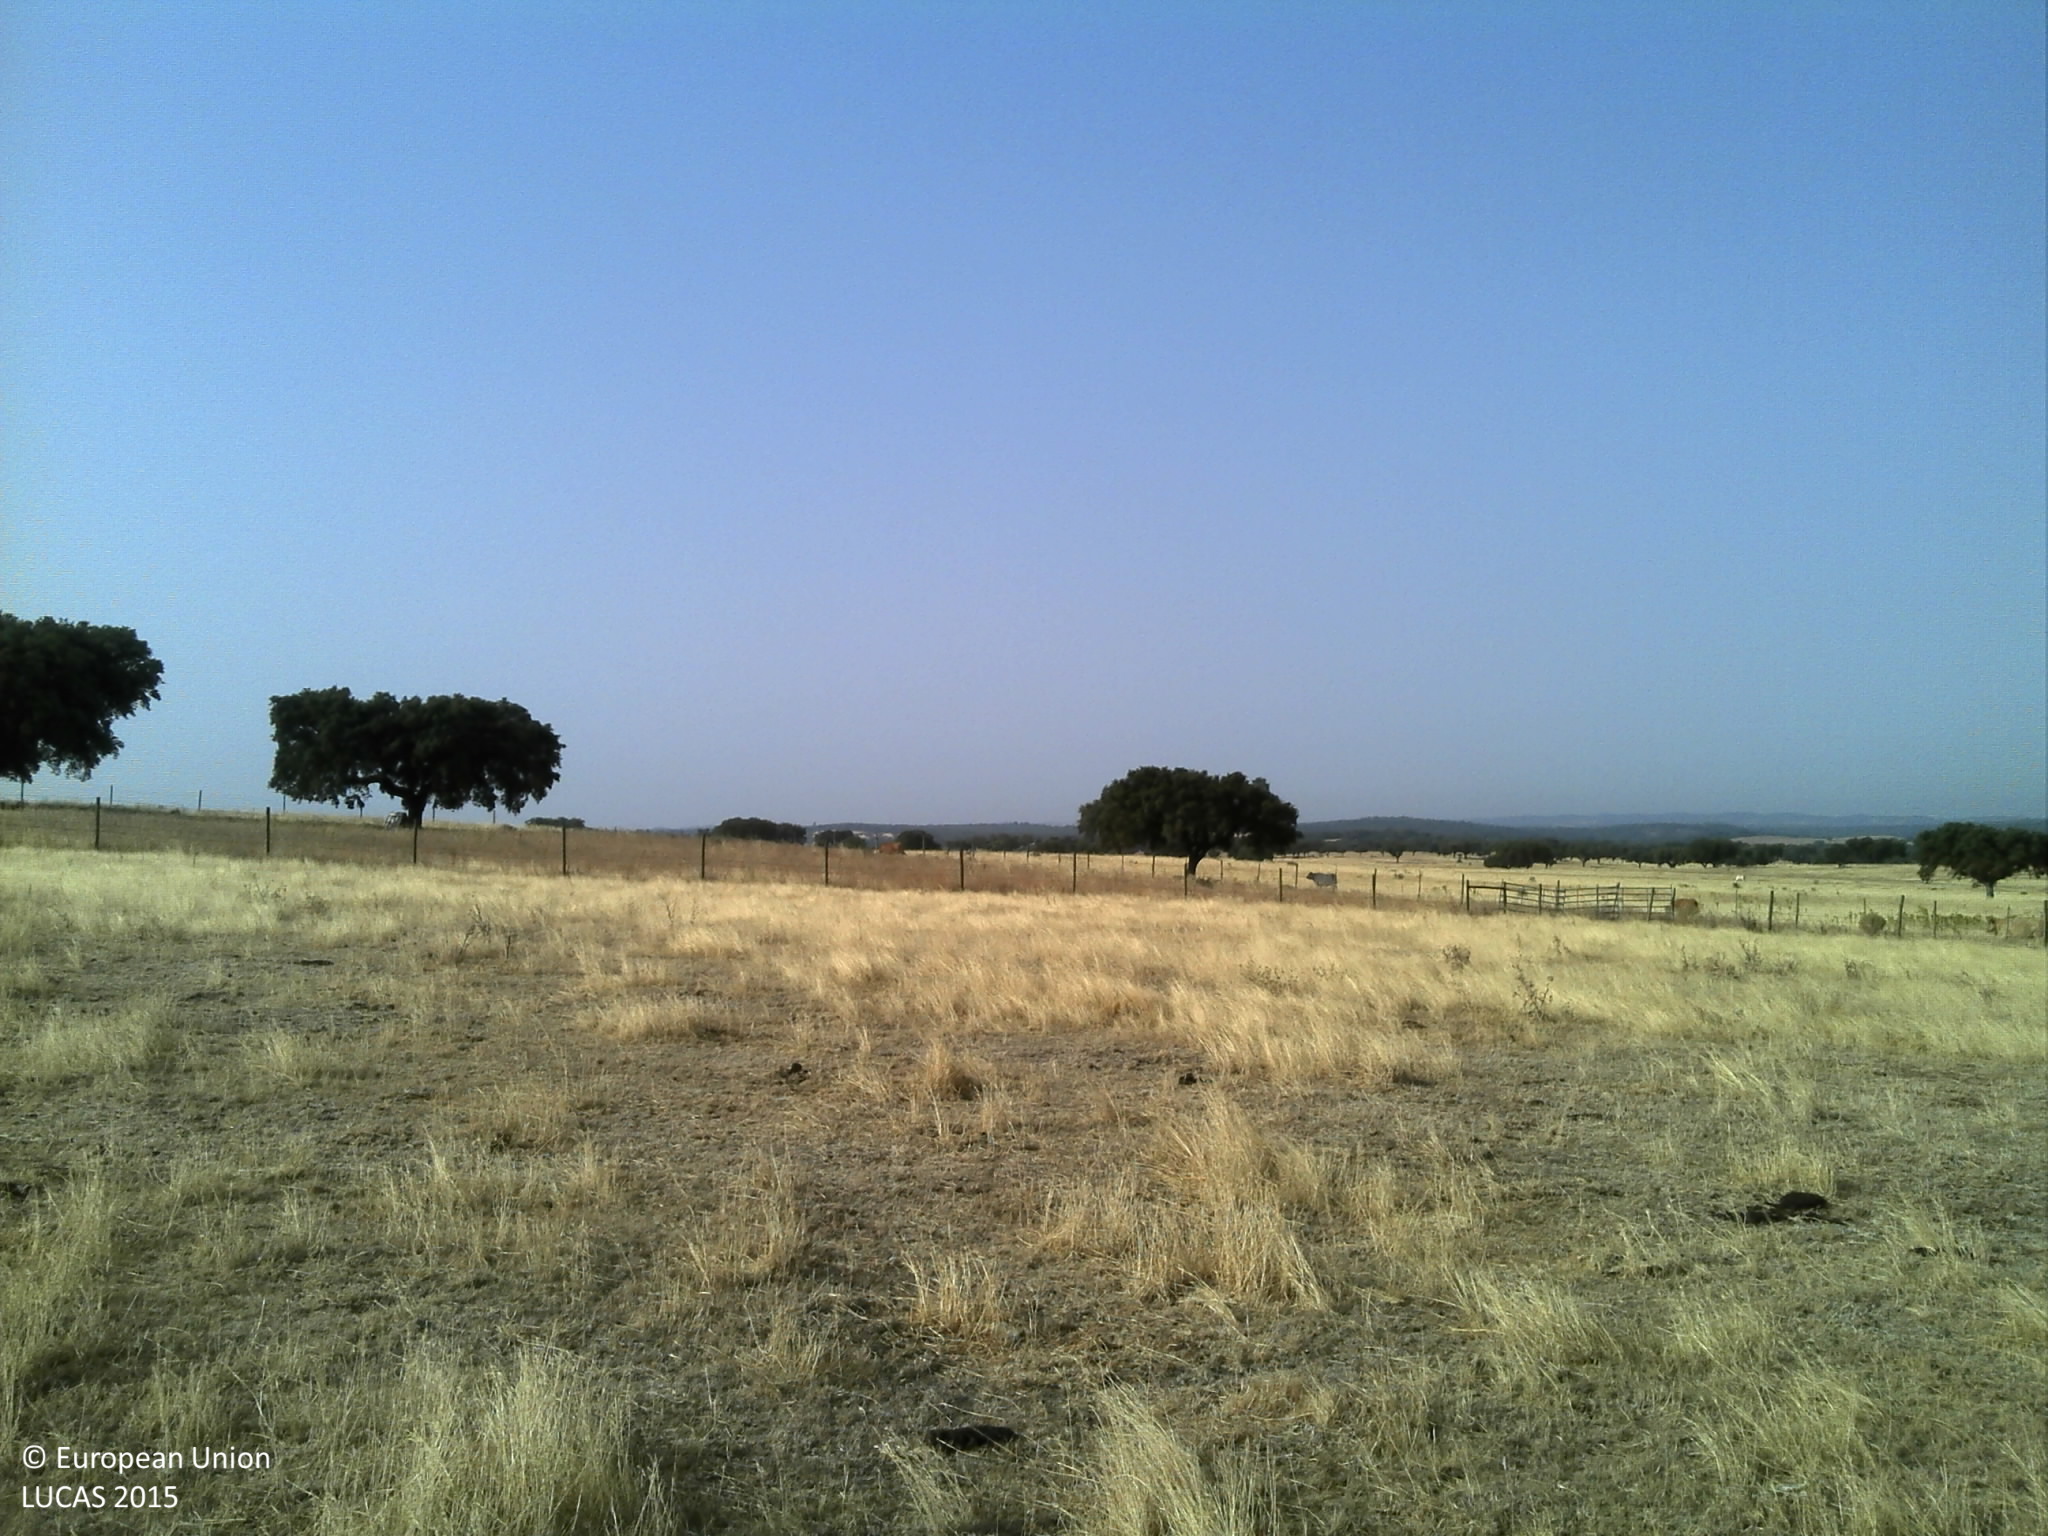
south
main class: Grassland
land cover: Grassland without tree/shrub cover
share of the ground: 25 - 50 %
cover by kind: unconsolidated bare surface 60 %, herbaceous plants 40 %
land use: Agriculture (excluding fallow land and kitchen gardens)
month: July
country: PT
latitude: 38.7077
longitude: -7.4531
